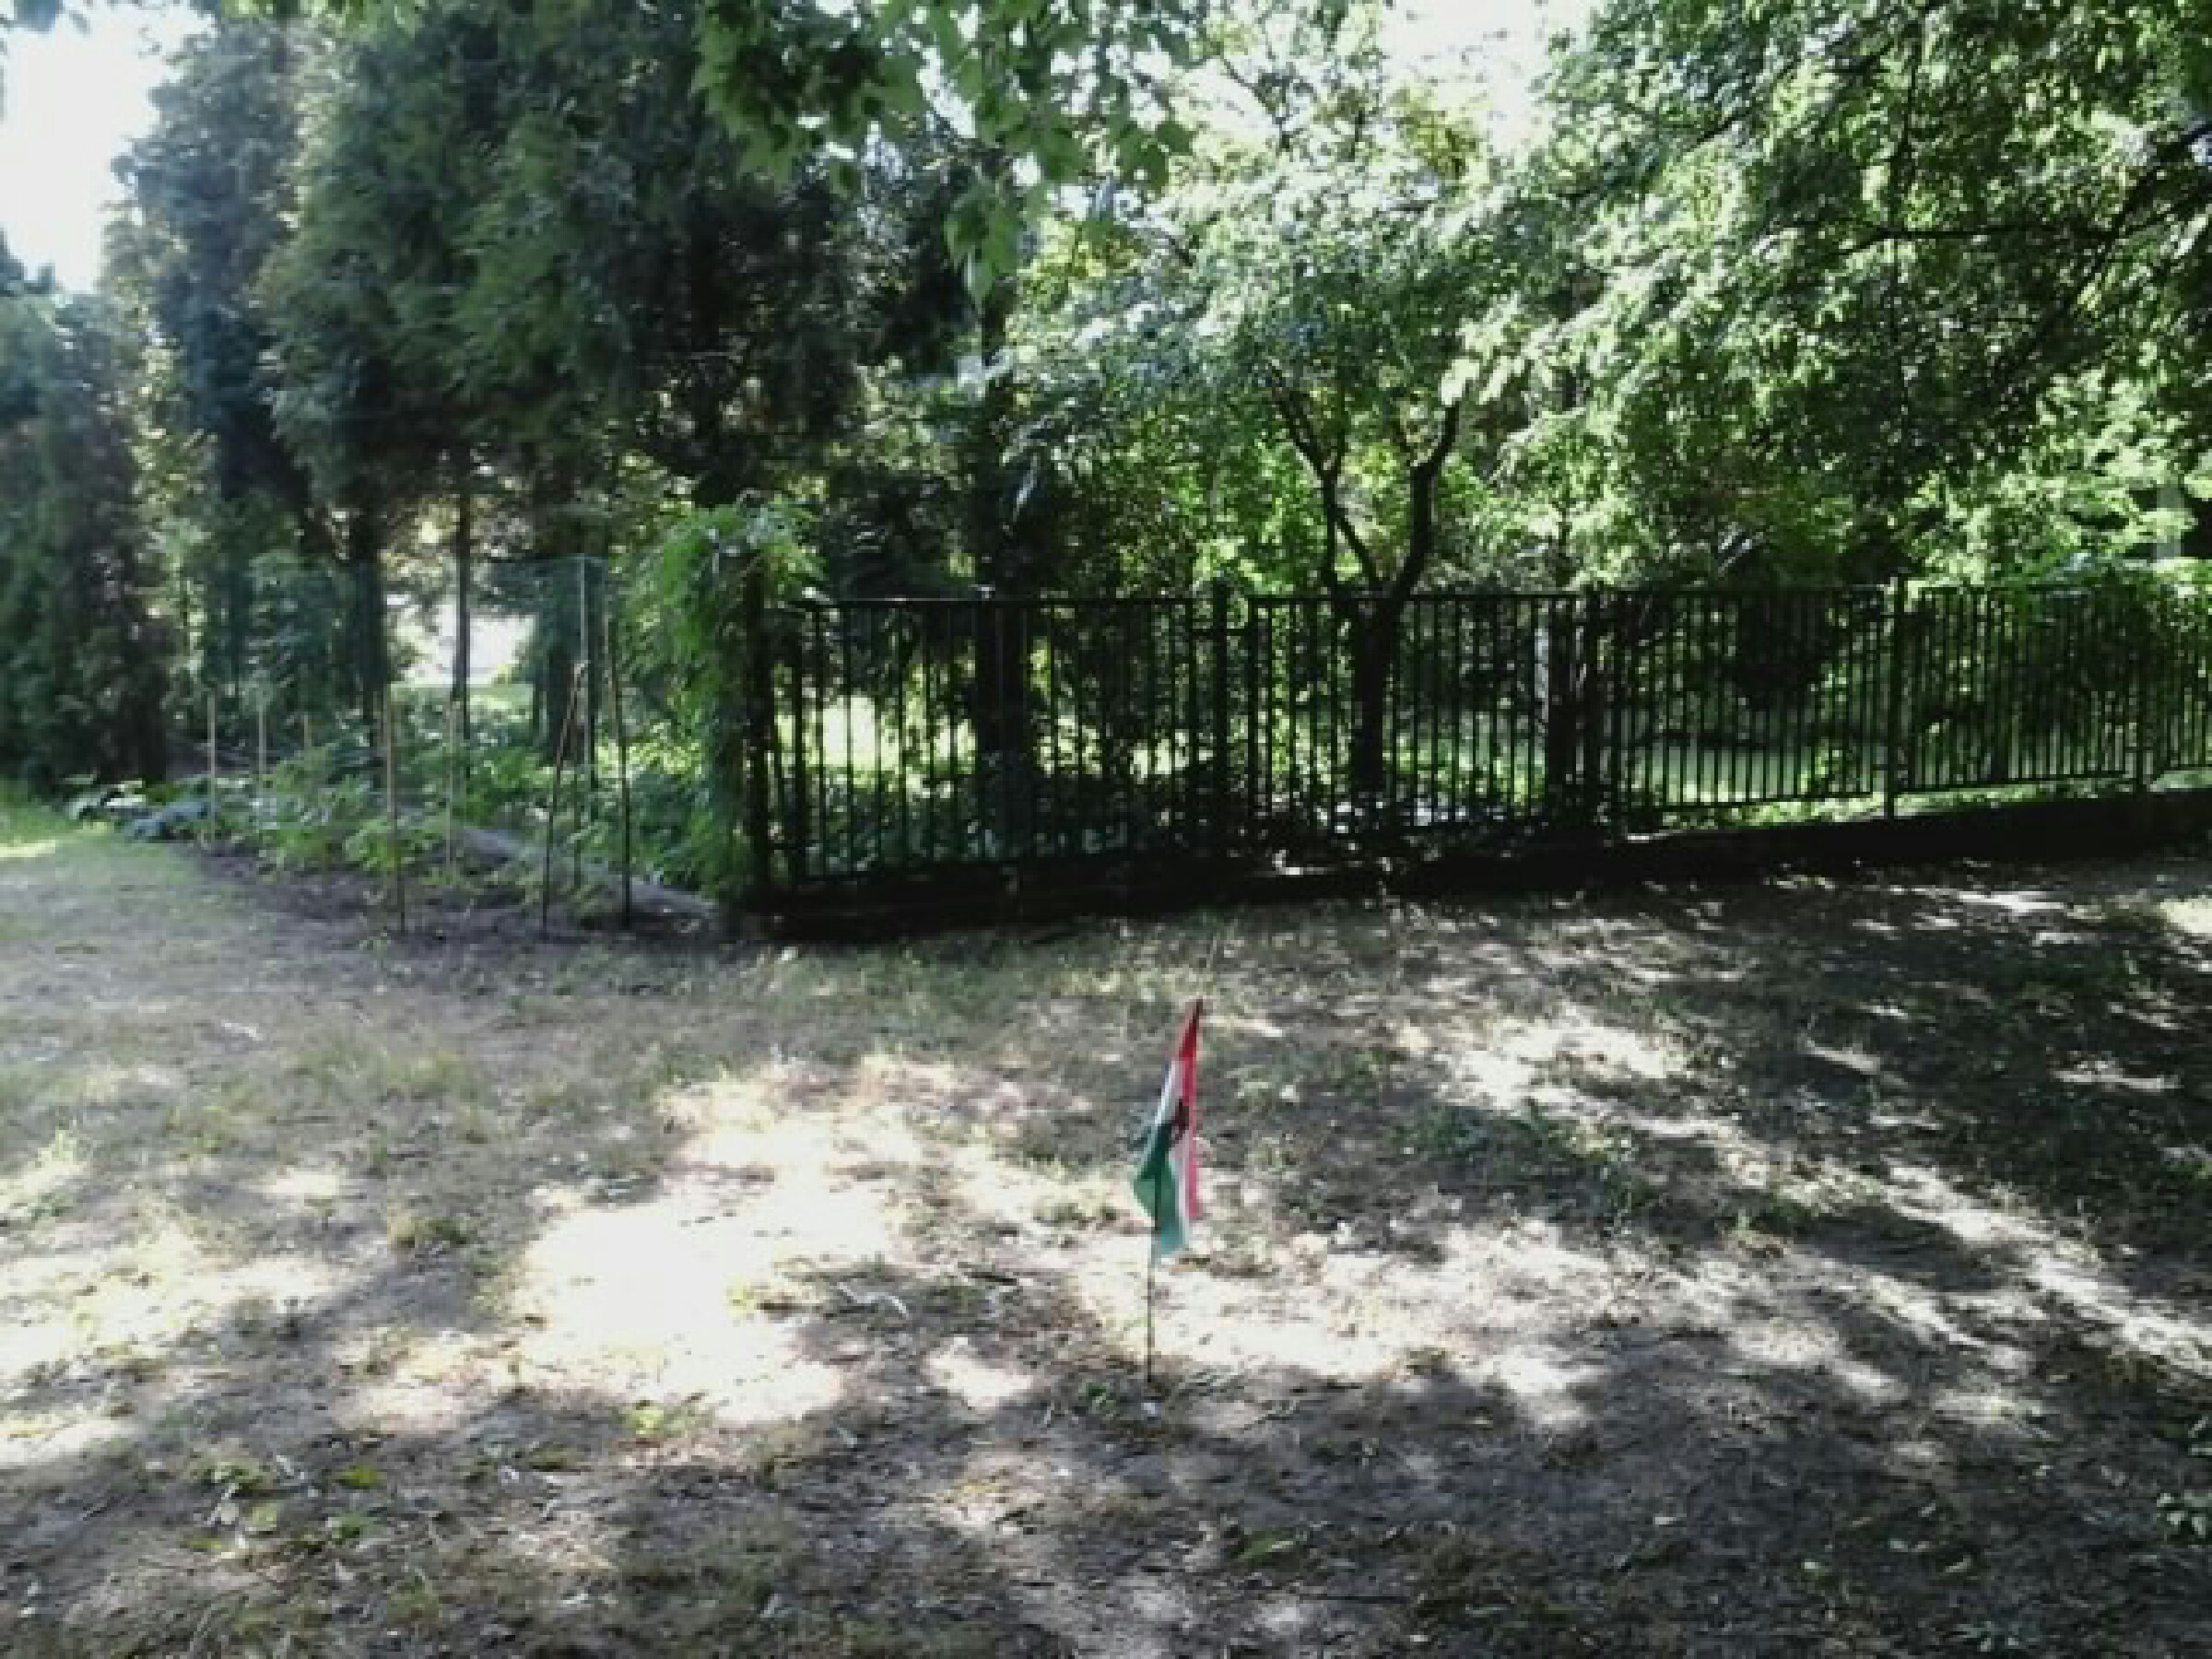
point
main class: Woodland
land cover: Broadleaved woodland
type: mesophytic deciduous forest
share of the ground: > 75 %
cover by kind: broadleaved forest trees 95 %, herbaceous plants 5 %
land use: Amenities, museums, leisure
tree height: > 5 m
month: July
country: HU
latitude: 47.6799
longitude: 19.1438
